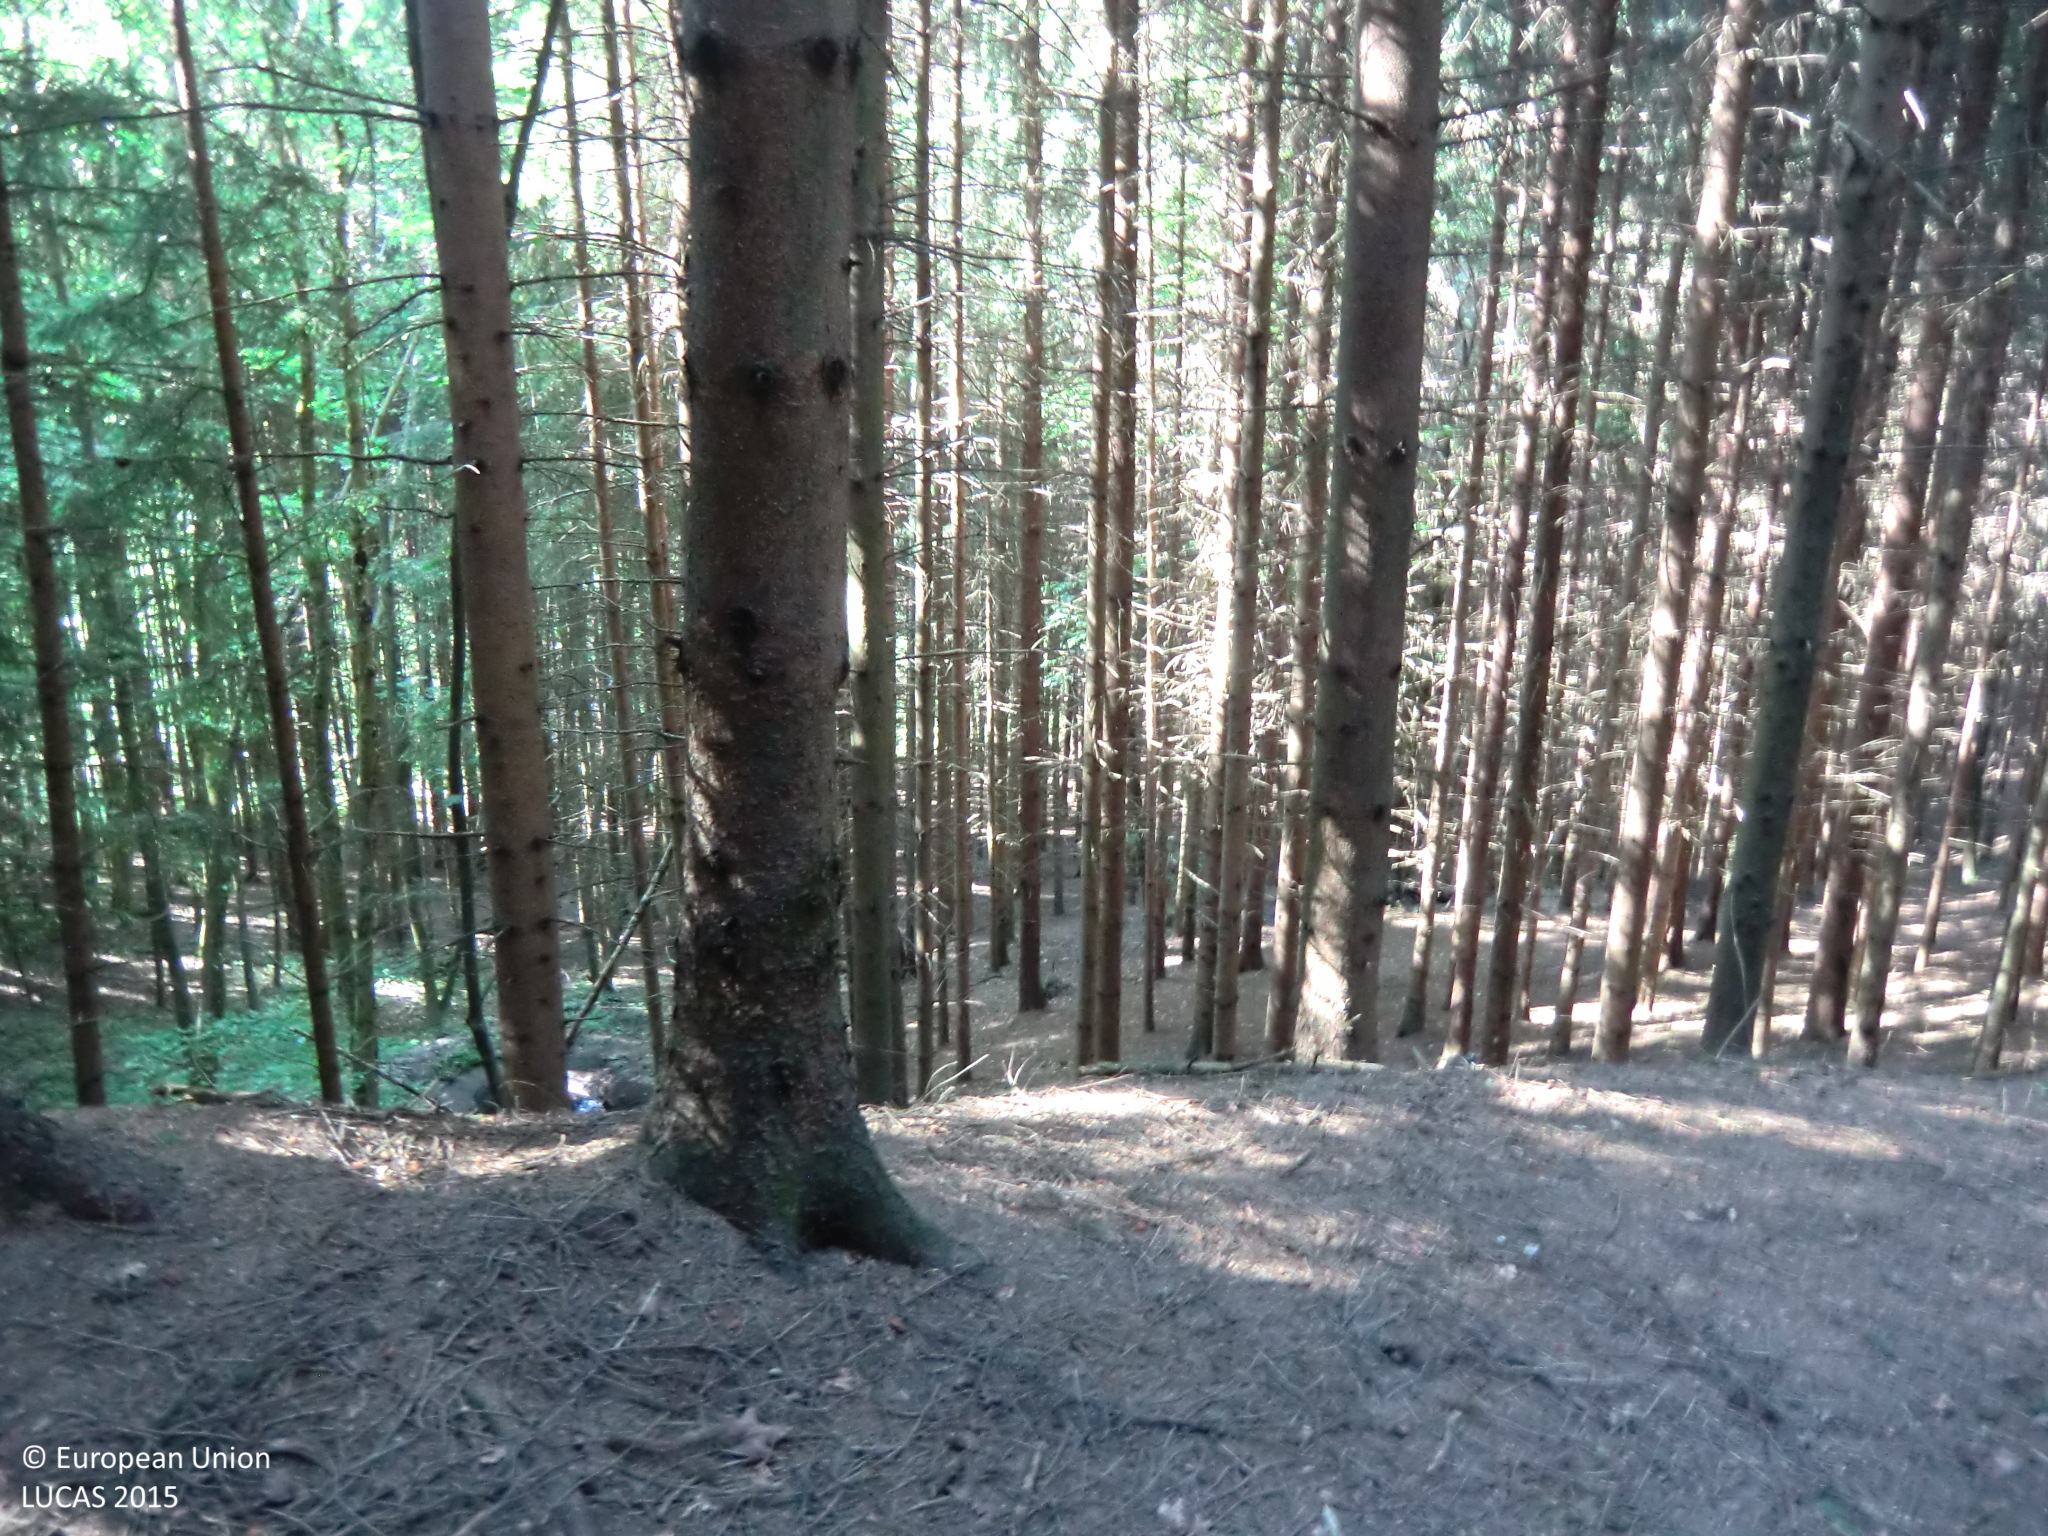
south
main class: Woodland
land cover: Spruce dominated coniferous woodland
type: hemiboreal forest and nemoral coniferous forest and mixed broadleaved-coniferous forest
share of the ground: > 75 %
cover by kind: coniferous forest trees 80 %, unconsolidated bare surface 20 %
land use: Forestry
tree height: > 5 m
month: June
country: AT
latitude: 48.2724
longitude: 15.0000
